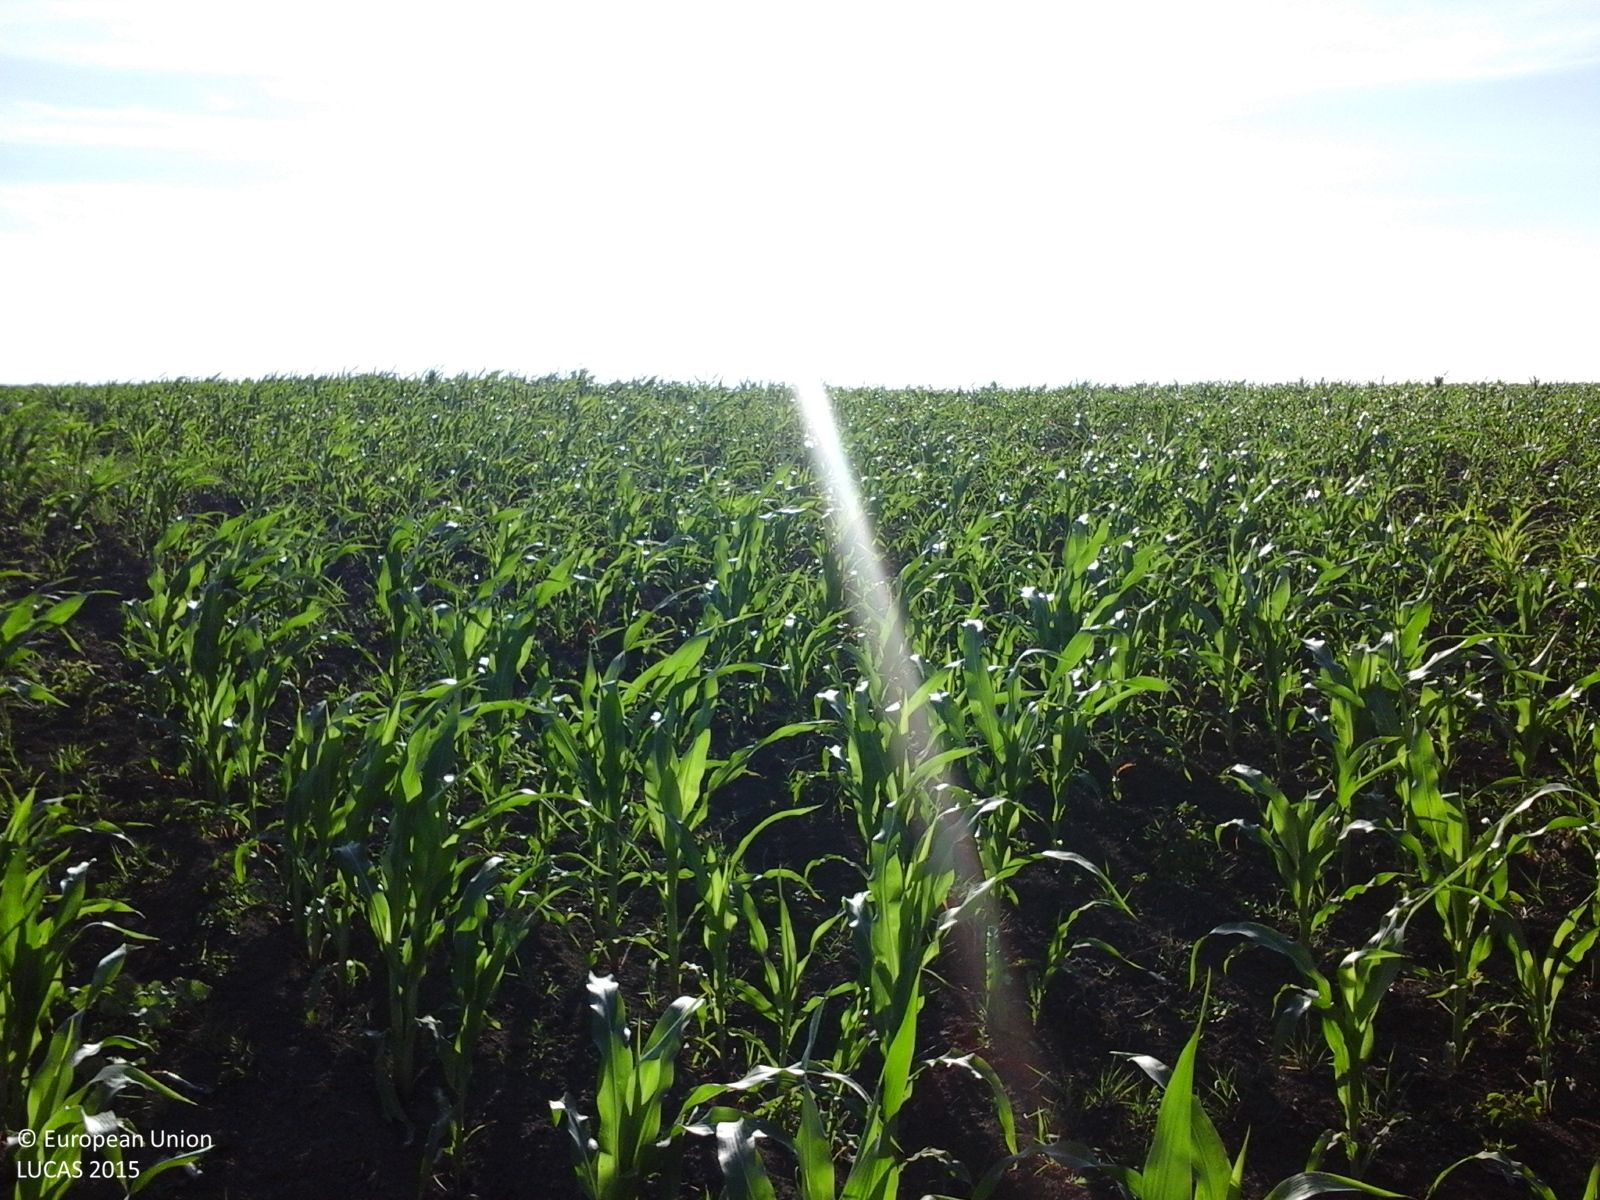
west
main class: Cropland
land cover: Maize
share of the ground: 25 - 50 %
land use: Agriculture (excluding fallow land and kitchen gardens)
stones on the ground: < 10 %
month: June
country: RO
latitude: 47.8374
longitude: 27.1723
